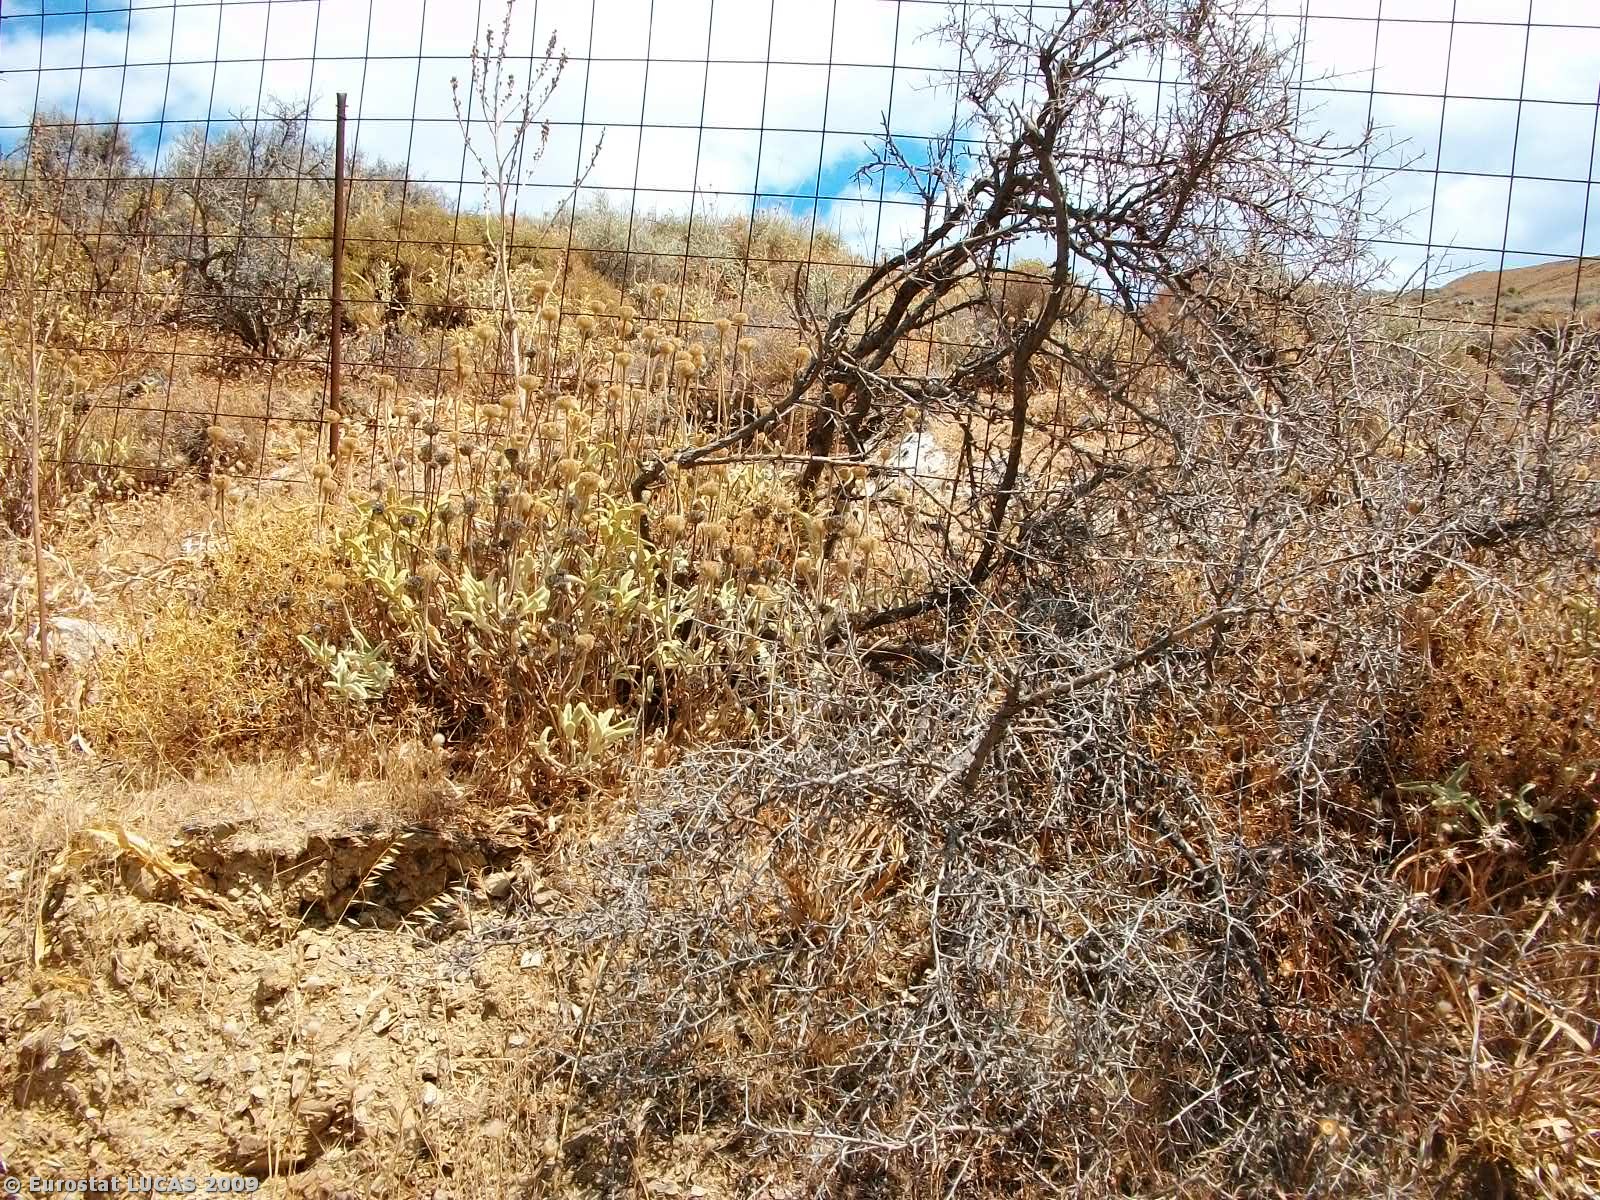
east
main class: Shrubland
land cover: Shrubland without tree cover
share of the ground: > 75 %
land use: Unused
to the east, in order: Shrubland without tree cover; Rivers and streams; Shrubland without tree cover; Rivers and streams; Shrubland without tree cover; Rivers and streams; Shrubland without tree cover; Tracks; Shrubland without tree cover
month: July
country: GR
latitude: 34.9944
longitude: 25.0499
